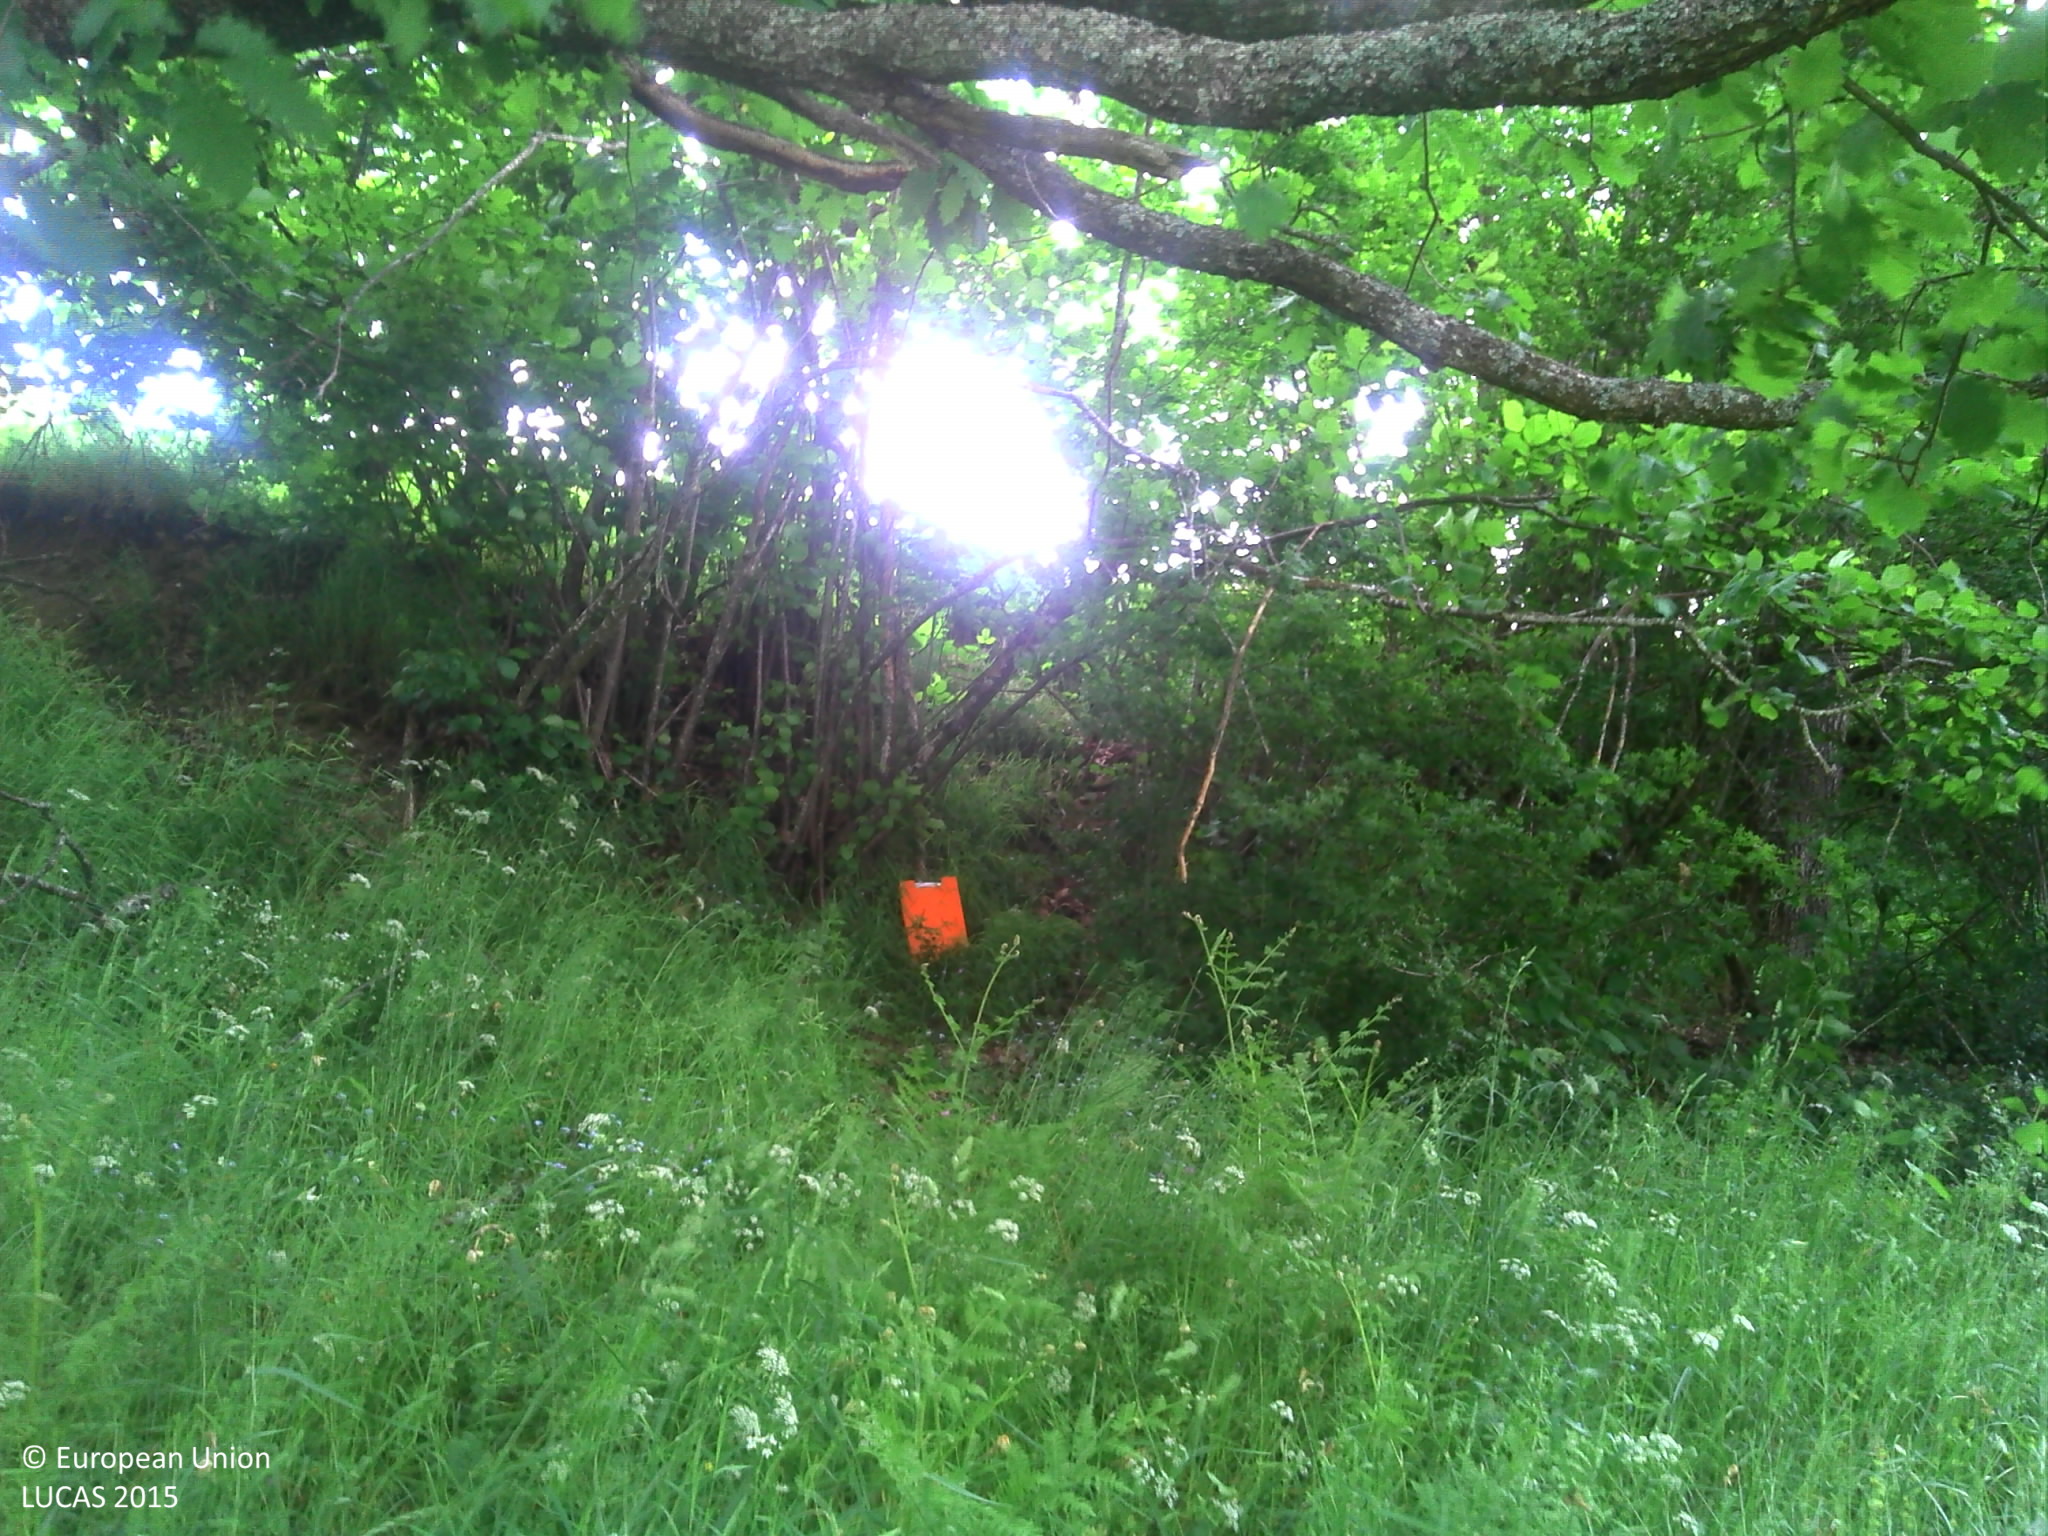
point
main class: Woodland
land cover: Broadleaved woodland
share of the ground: > 75 %
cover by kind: broadleaved forest trees 70 %, herbaceous plants 20 %, shrubs 10 %
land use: Agriculture (excluding fallow land and kitchen gardens)
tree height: > 5 m
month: June
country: FR
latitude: 45.1240
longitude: 3.2261
